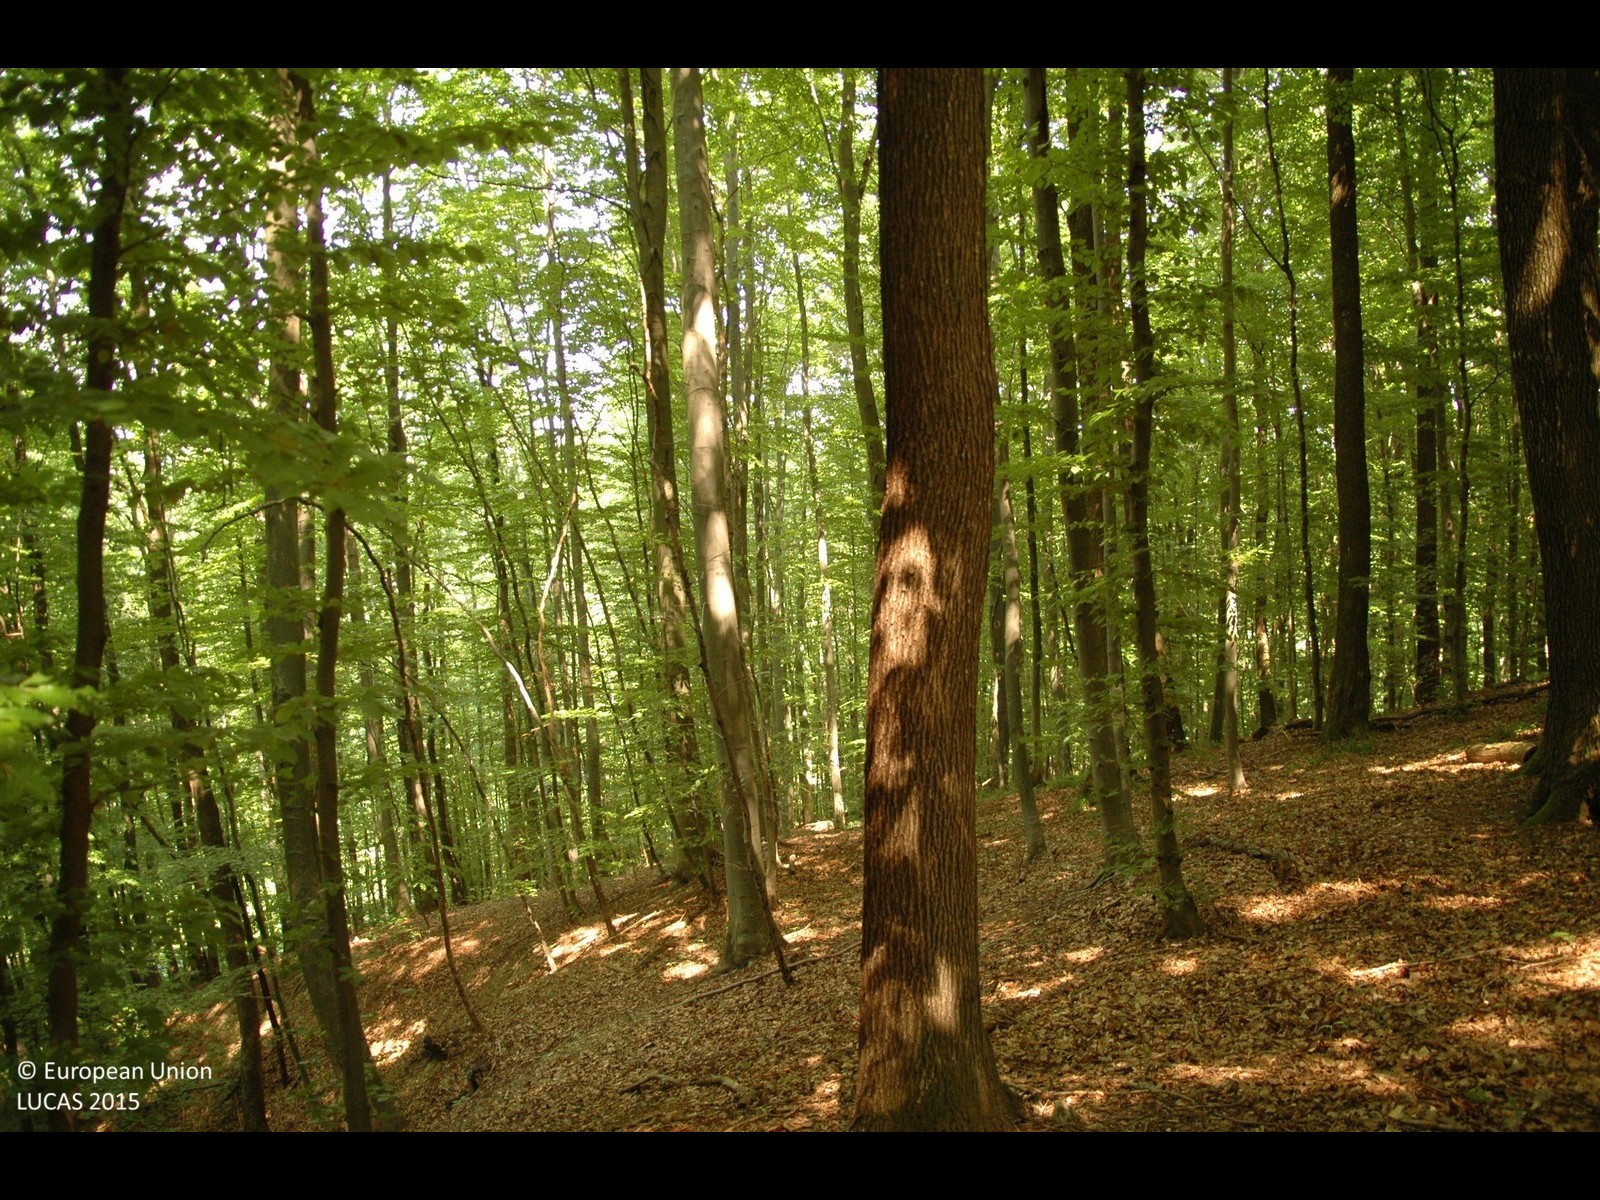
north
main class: Woodland
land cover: Broadleaved woodland
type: mesophytic deciduous forest
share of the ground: > 75 %
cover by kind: broadleaved forest trees 100 %
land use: Forestry
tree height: > 5 m
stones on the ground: < 10 %
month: July
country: HR
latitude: 46.1674
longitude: 16.5668
